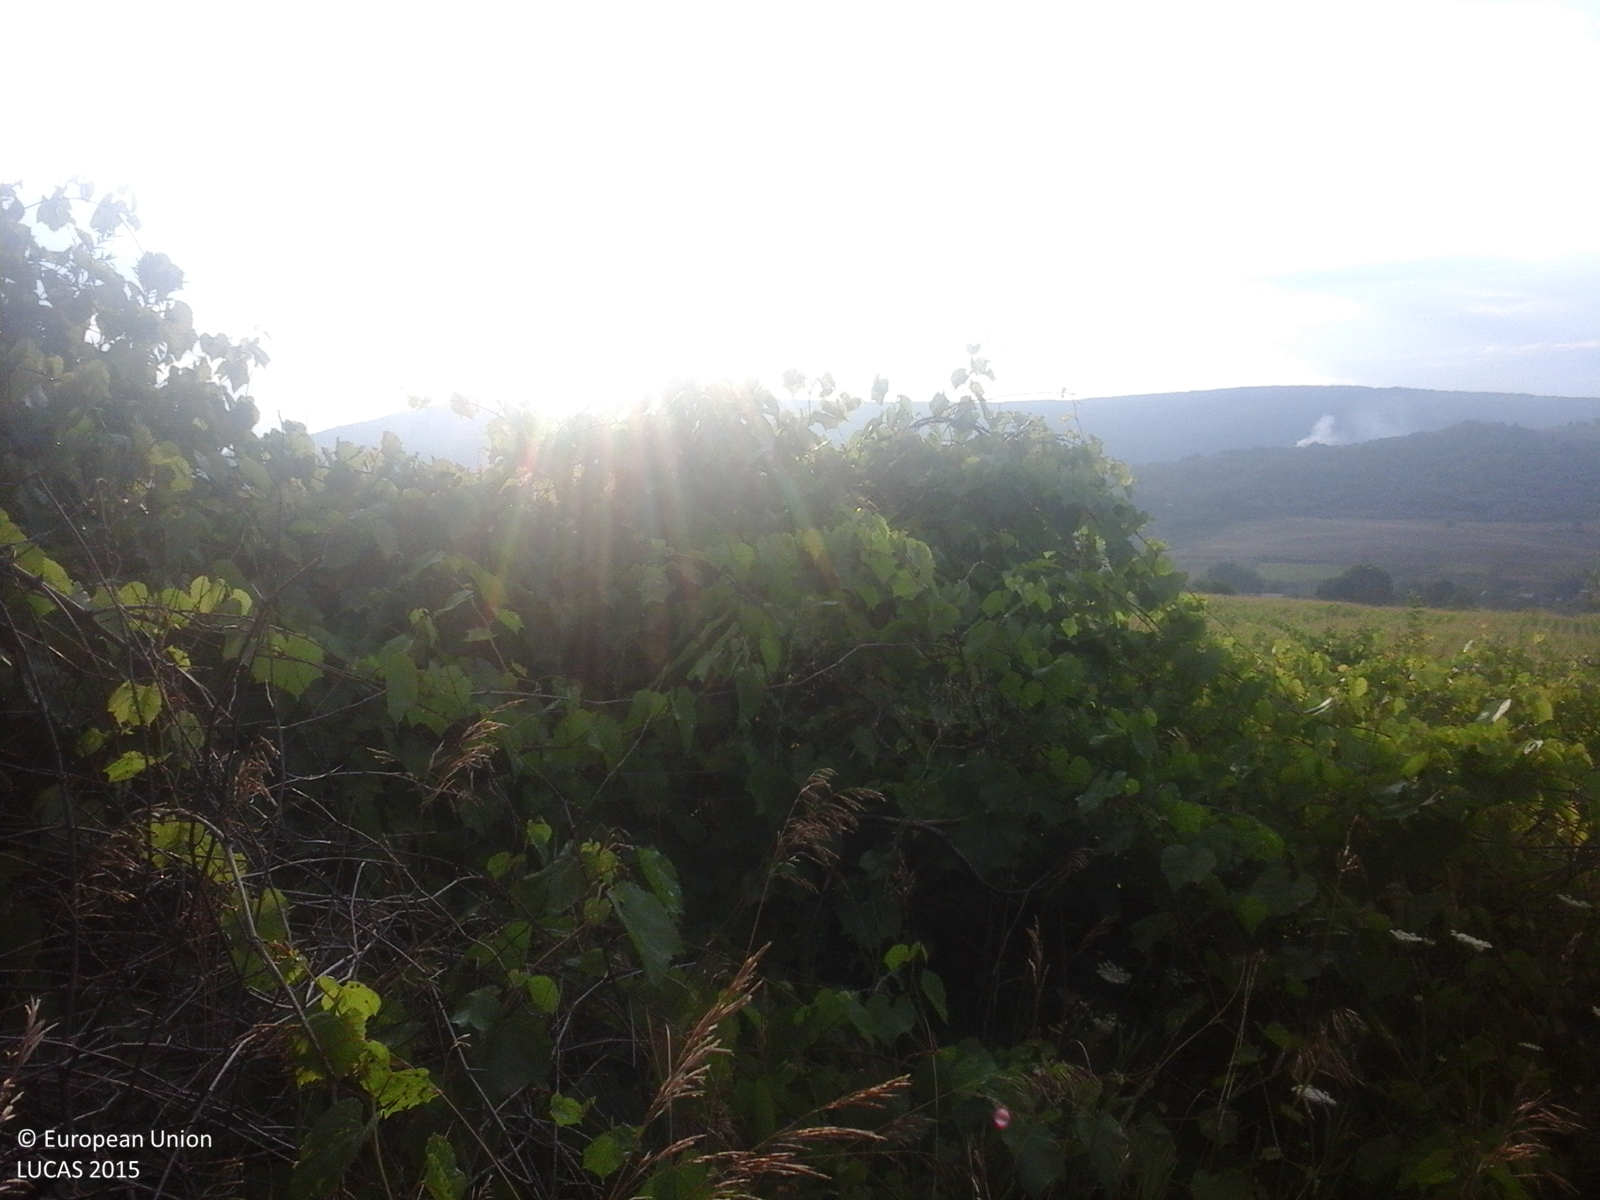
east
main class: Woodland
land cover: Broadleaved woodland
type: exotic forest
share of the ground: > 75 %
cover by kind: broadleaved forest trees 100 %
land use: Semi-natural and natural areas not in use
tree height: > 5 m
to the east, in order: Broadleaved woodland; Vineyards; Tracks; Maize; Vineyards; Grassland with sparse tree/shrub cover; Vineyards; Maize
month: July
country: RO
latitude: 46.5660
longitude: 27.8518
